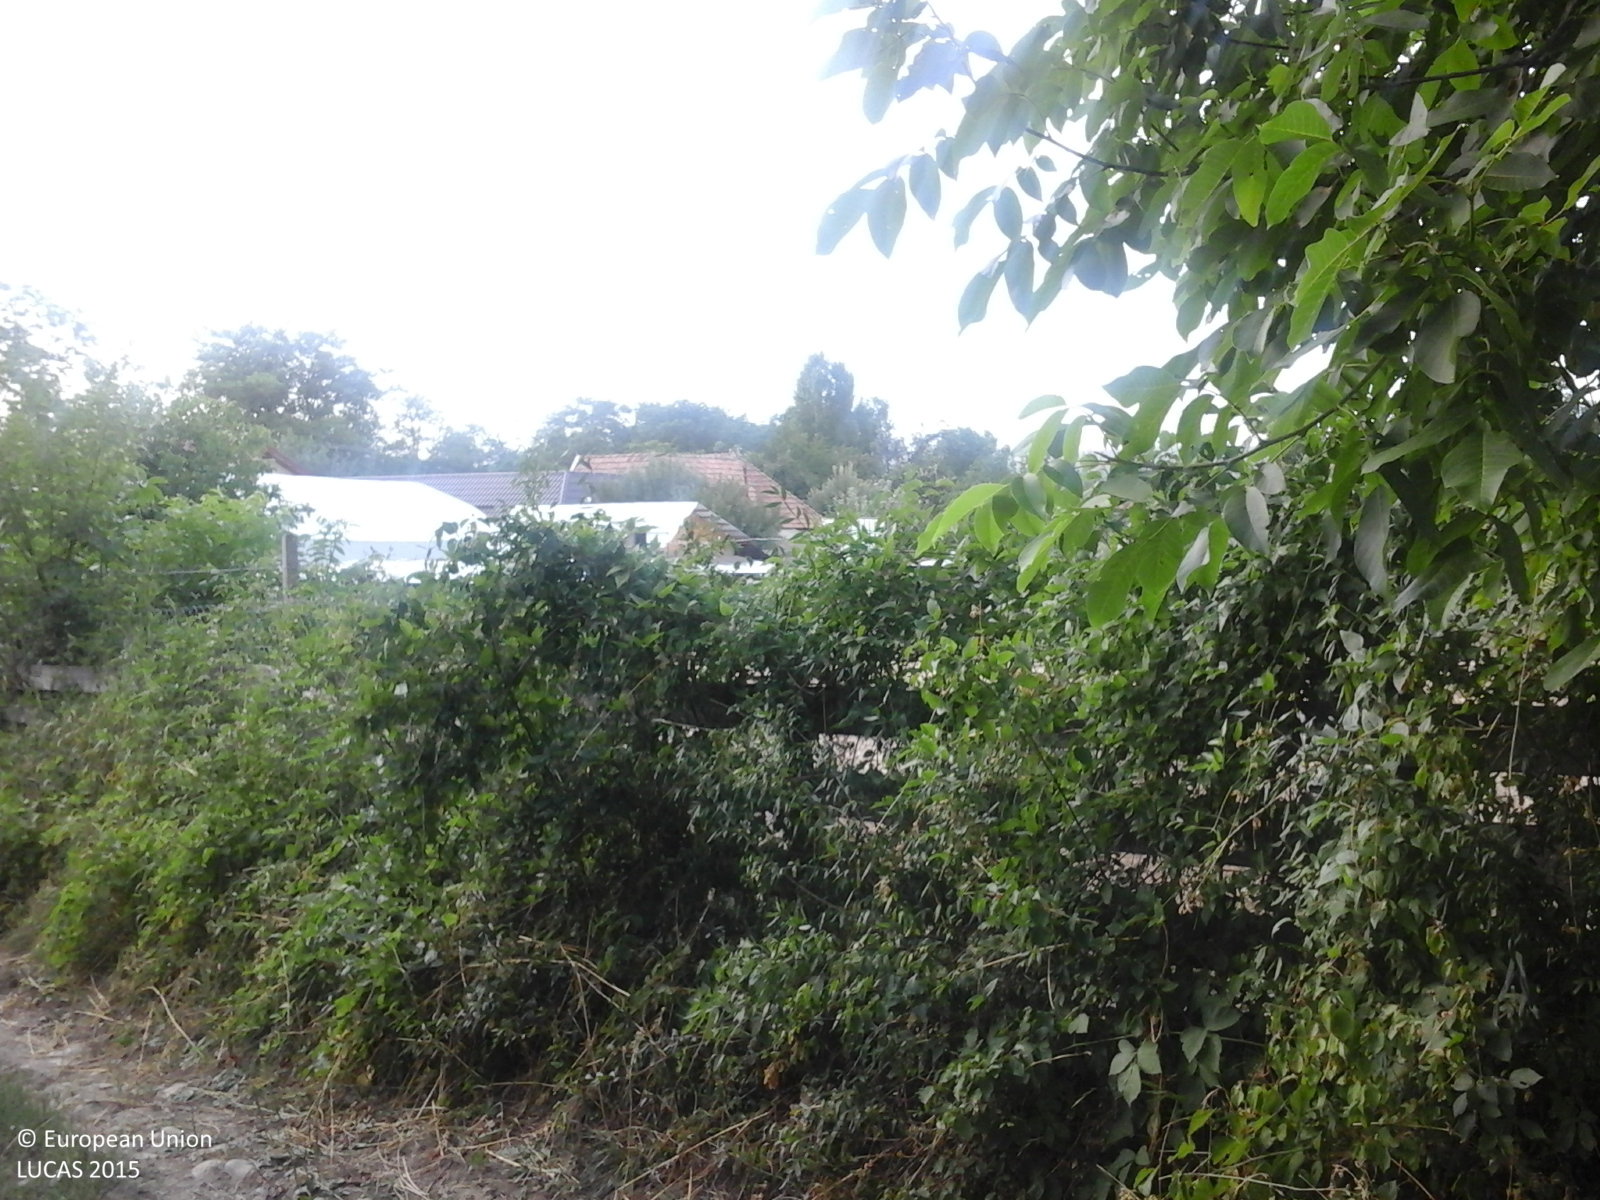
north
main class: Cropland
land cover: Permanent crops (only in case pi)
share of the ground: > 75 %
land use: Agriculture (excluding fallow land and kitchen gardens)
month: July
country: RO
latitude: 46.2046
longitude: 26.6870
